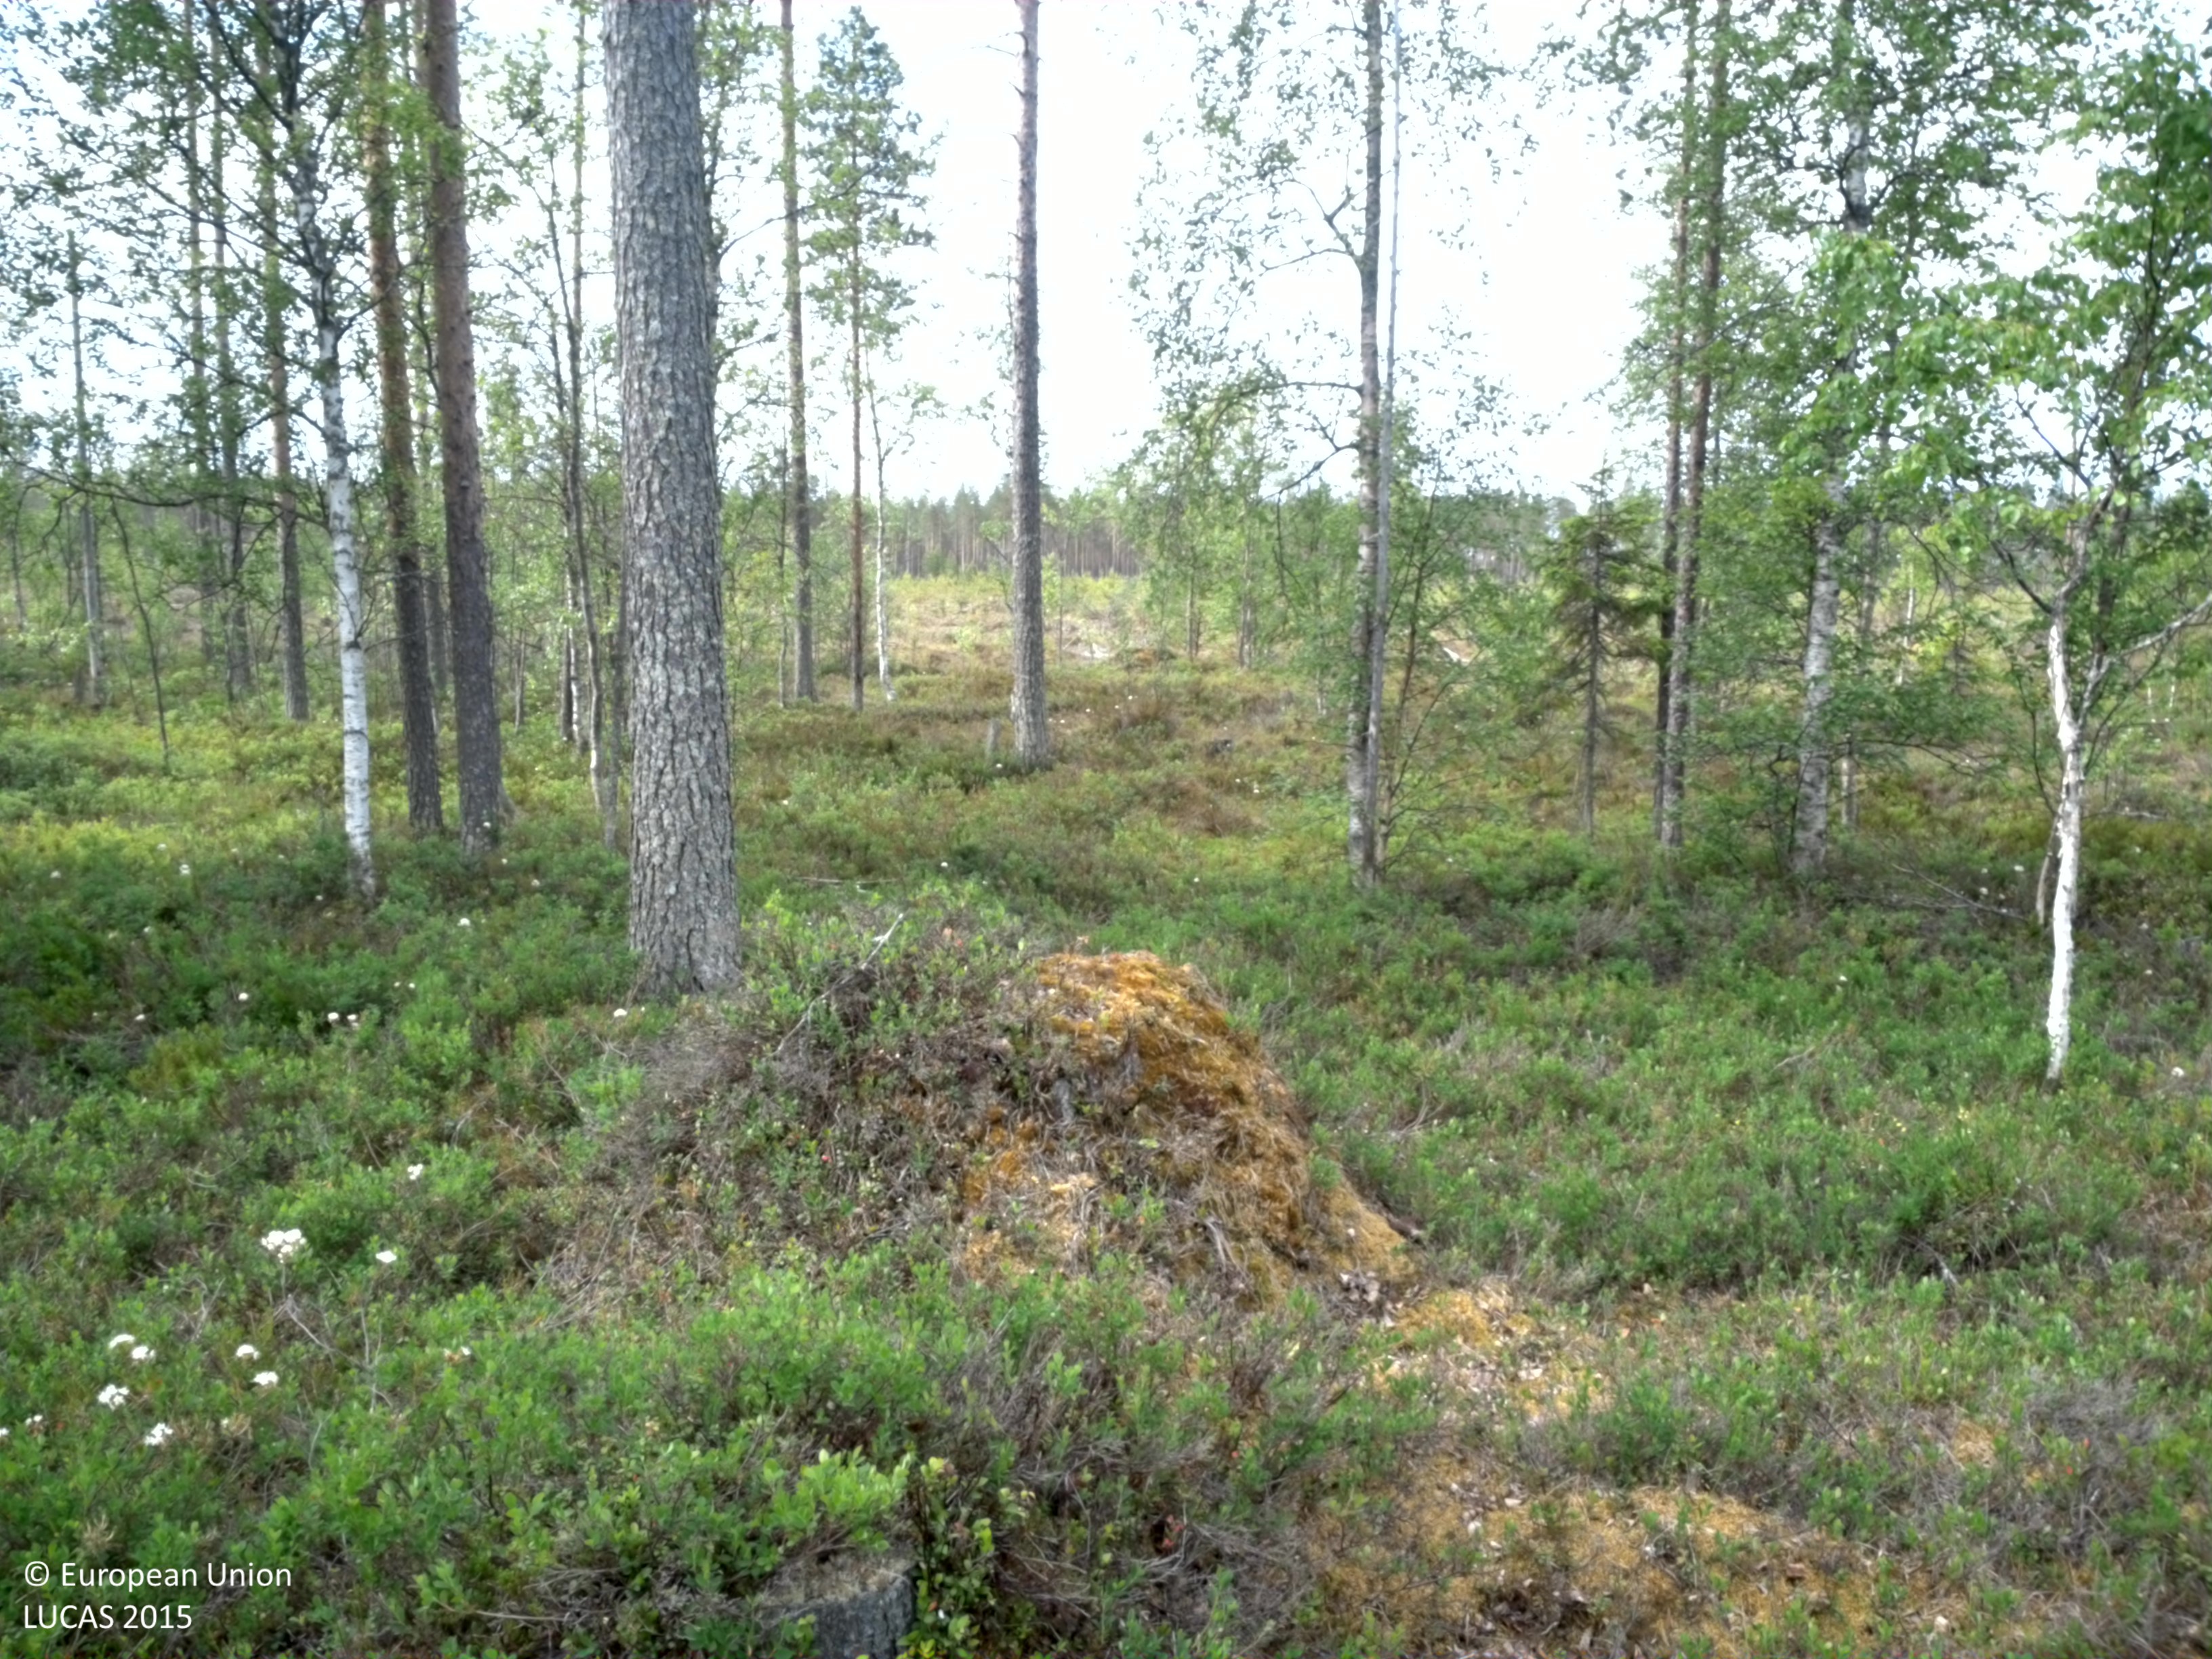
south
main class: Woodland
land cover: Pine dominated mixed woodland
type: boreal forest
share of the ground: 25 - 50 %
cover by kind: shrubs 40 %, coniferous forest trees 30 %, lichens and mosses 20 %, broadleaved forest trees 10 %
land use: Forestry
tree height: < 5 m
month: July
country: SE
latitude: 64.5018
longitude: 20.8266
